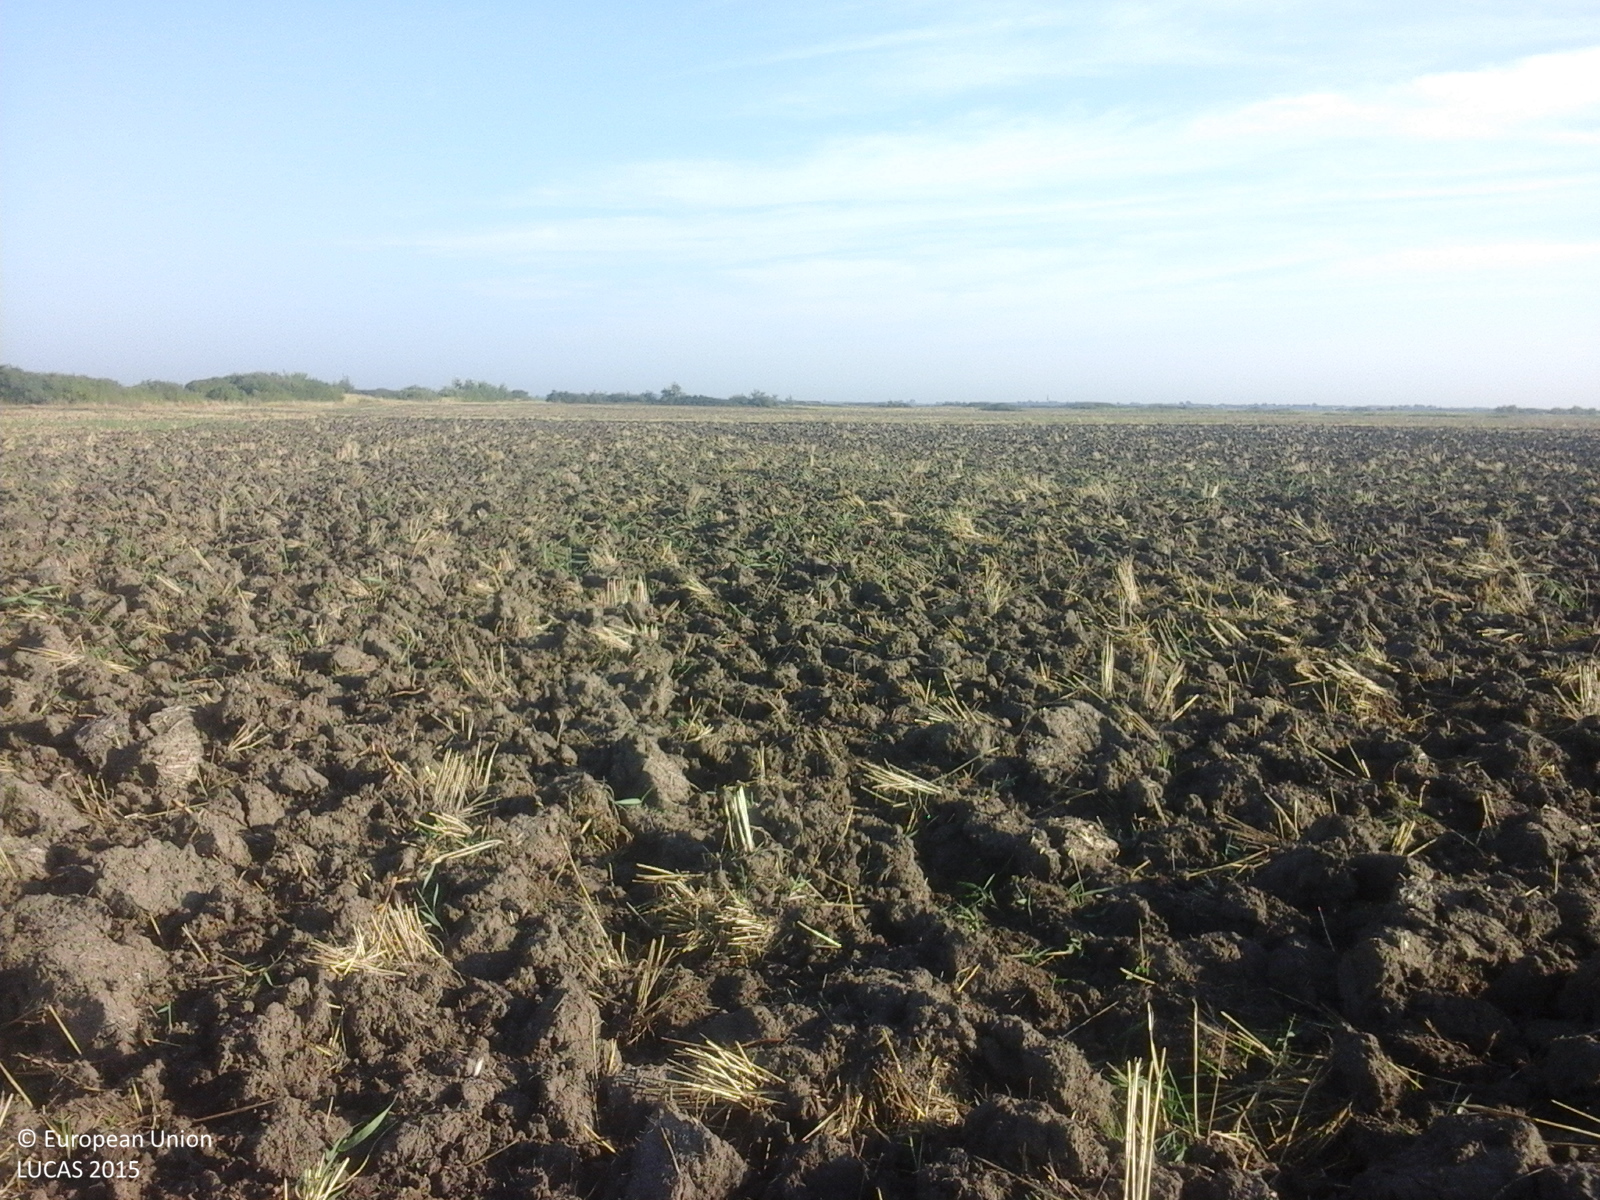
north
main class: Cropland
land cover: Common wheat
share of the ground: < 10 %
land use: Agriculture (excluding fallow land and kitchen gardens)
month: August
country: RO
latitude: 45.7261
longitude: 21.0141
